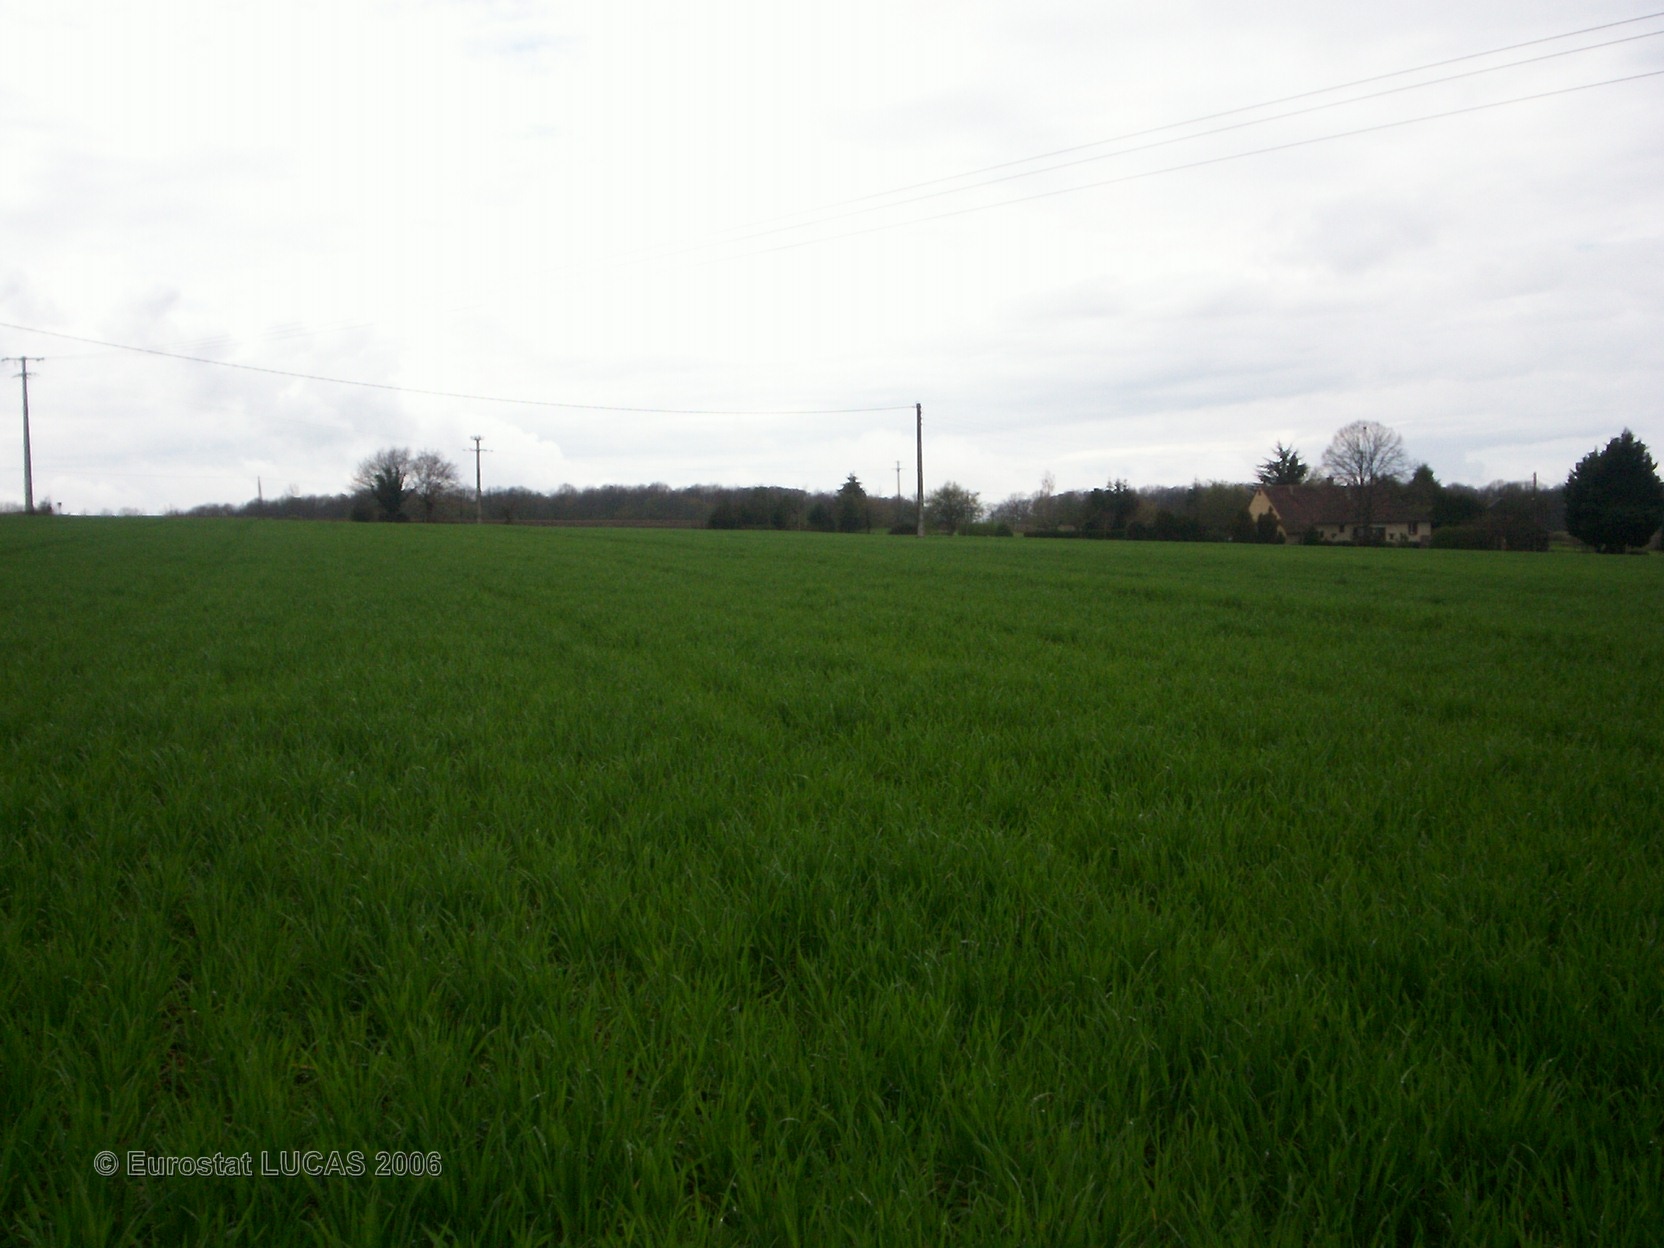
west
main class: Cropland
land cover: Barley
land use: Agriculture (excluding fallow land and kitchen gardens)
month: April
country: FR
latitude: 47.5147
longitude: 3.0229
